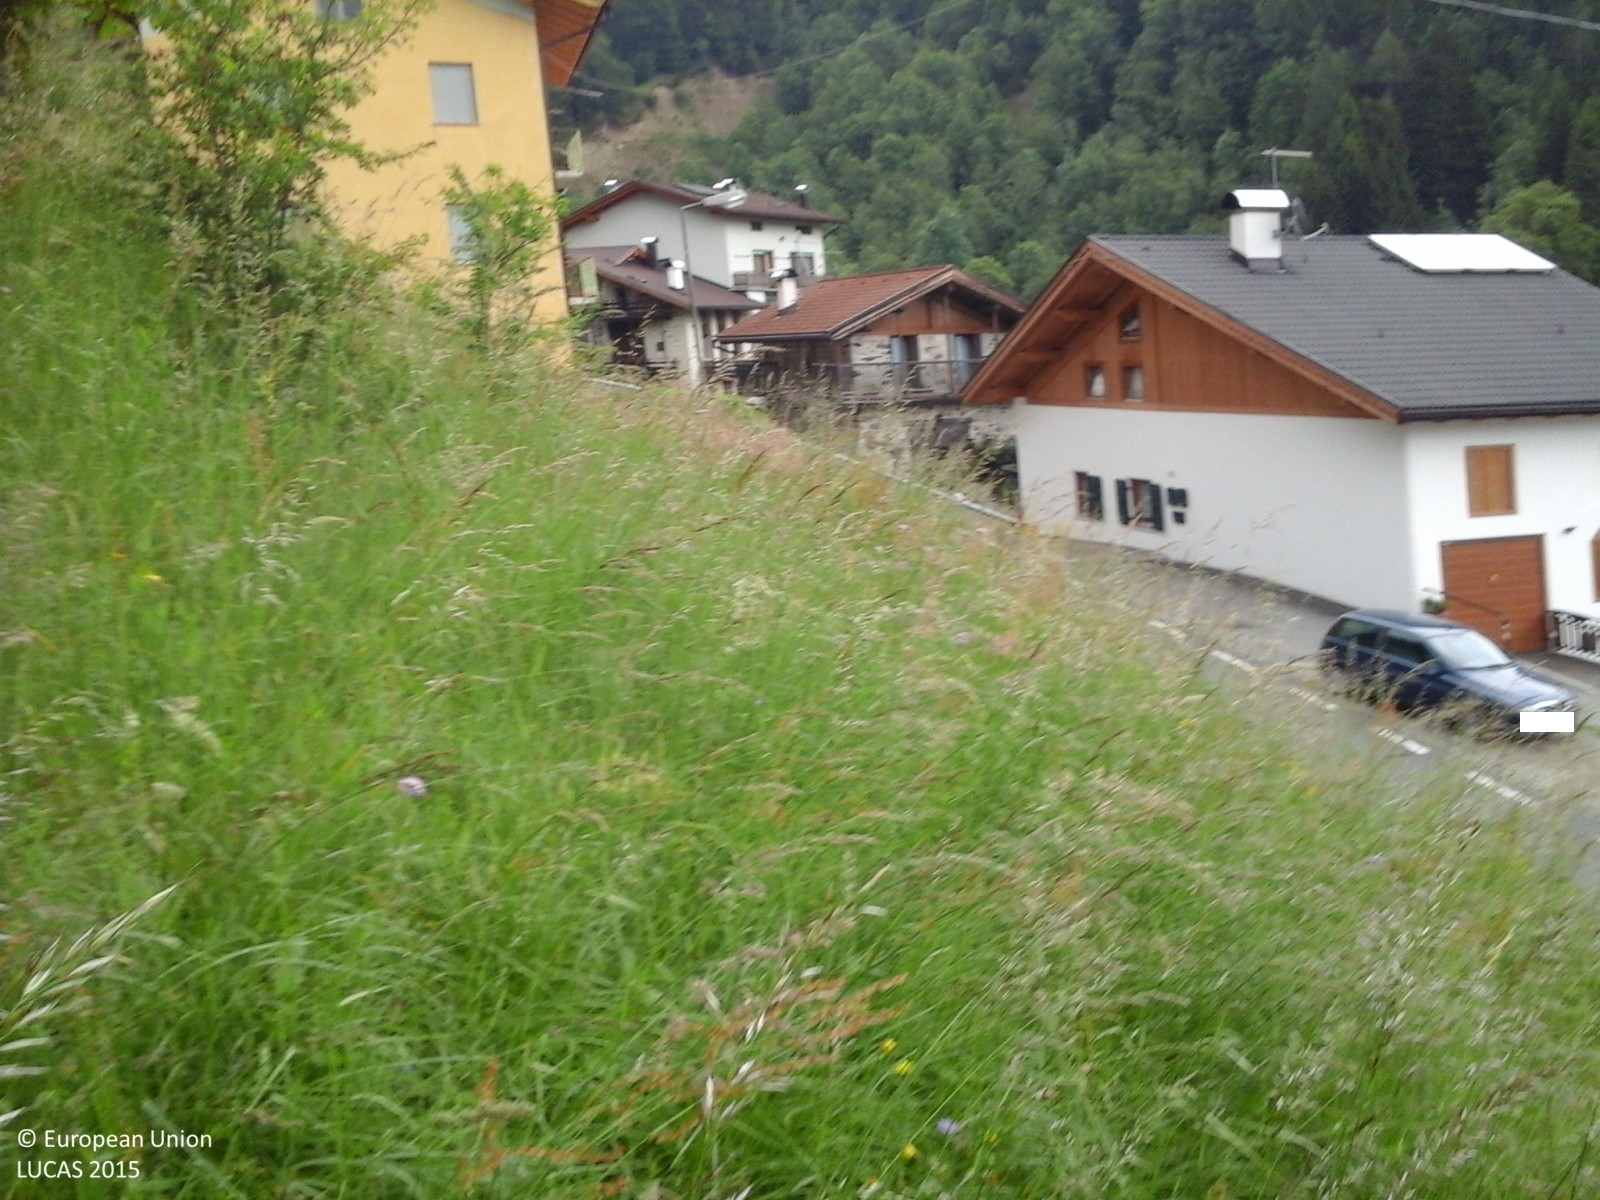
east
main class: Grassland
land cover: Grassland without tree/shrub cover
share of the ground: 50 - 75 %
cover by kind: herbaceous plants 70 %, consolidated bare surface 30 %
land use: Semi-natural and natural areas not in use
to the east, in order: Grassland without tree/shrub cover; Electric lines; Artificial constructions in urban areas; Grassland with sparse tree/shrub cover; Spruce dominated mixed woodland; Inland fresh running water; Other mixed woodland
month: May
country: IT
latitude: 46.1568
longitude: 11.7458
